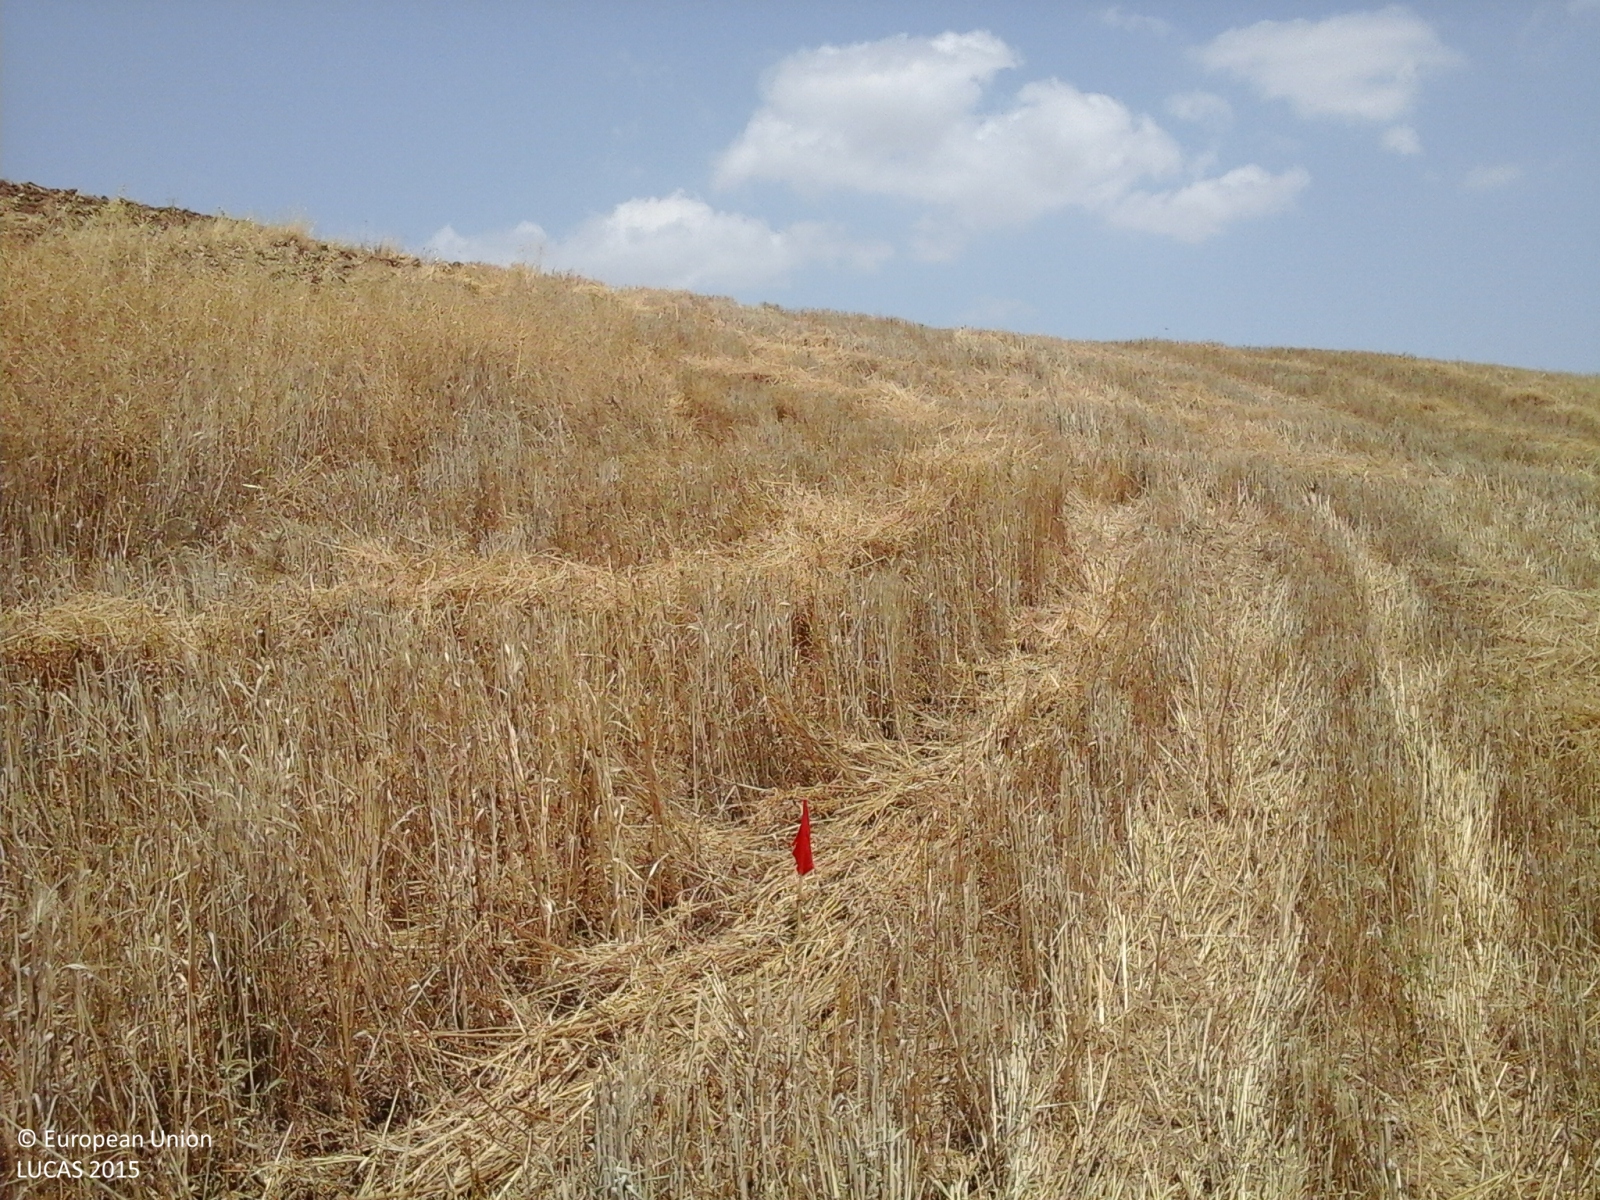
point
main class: Cropland
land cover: Durum wheat
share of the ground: > 75 %
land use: Agriculture (excluding fallow land and kitchen gardens)
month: July
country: IT
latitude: 37.3353
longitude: 14.0211
